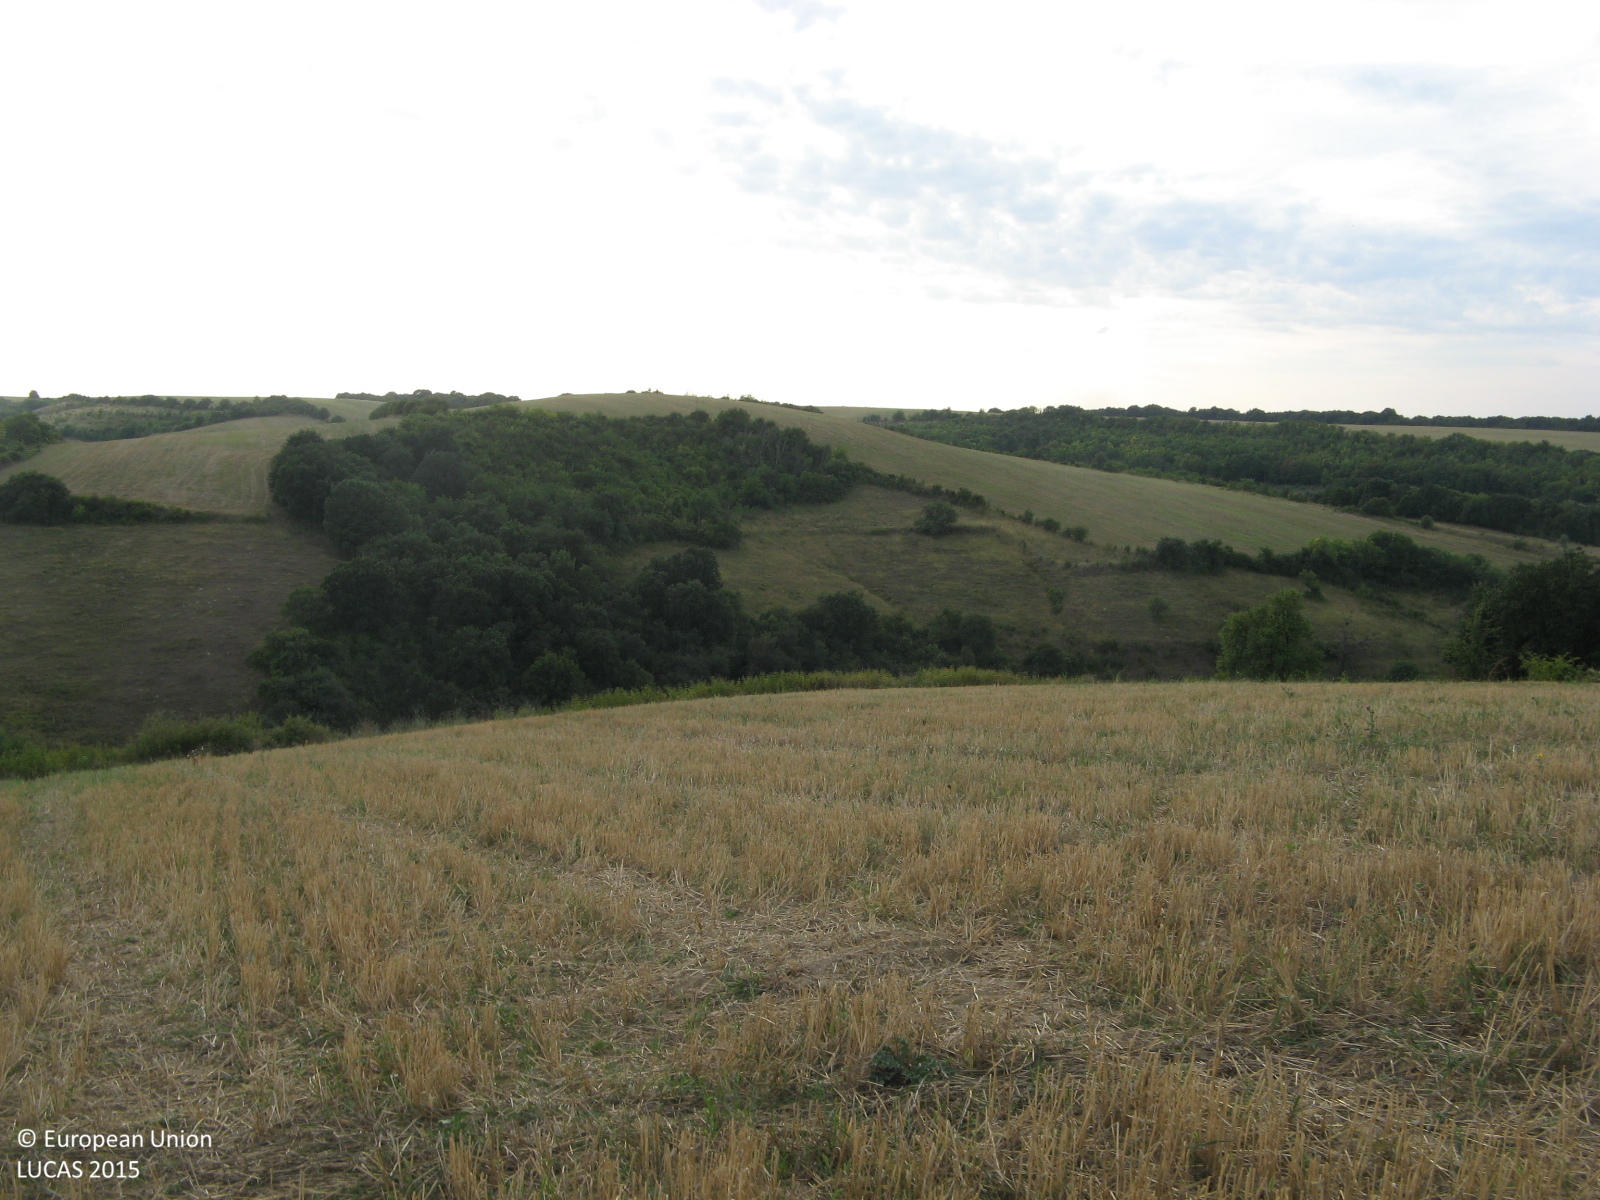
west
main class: Cropland
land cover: Common wheat
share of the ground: 25 - 50 %
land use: Agriculture (excluding fallow land and kitchen gardens)
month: August
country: BG
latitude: 43.6214
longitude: 25.7143
